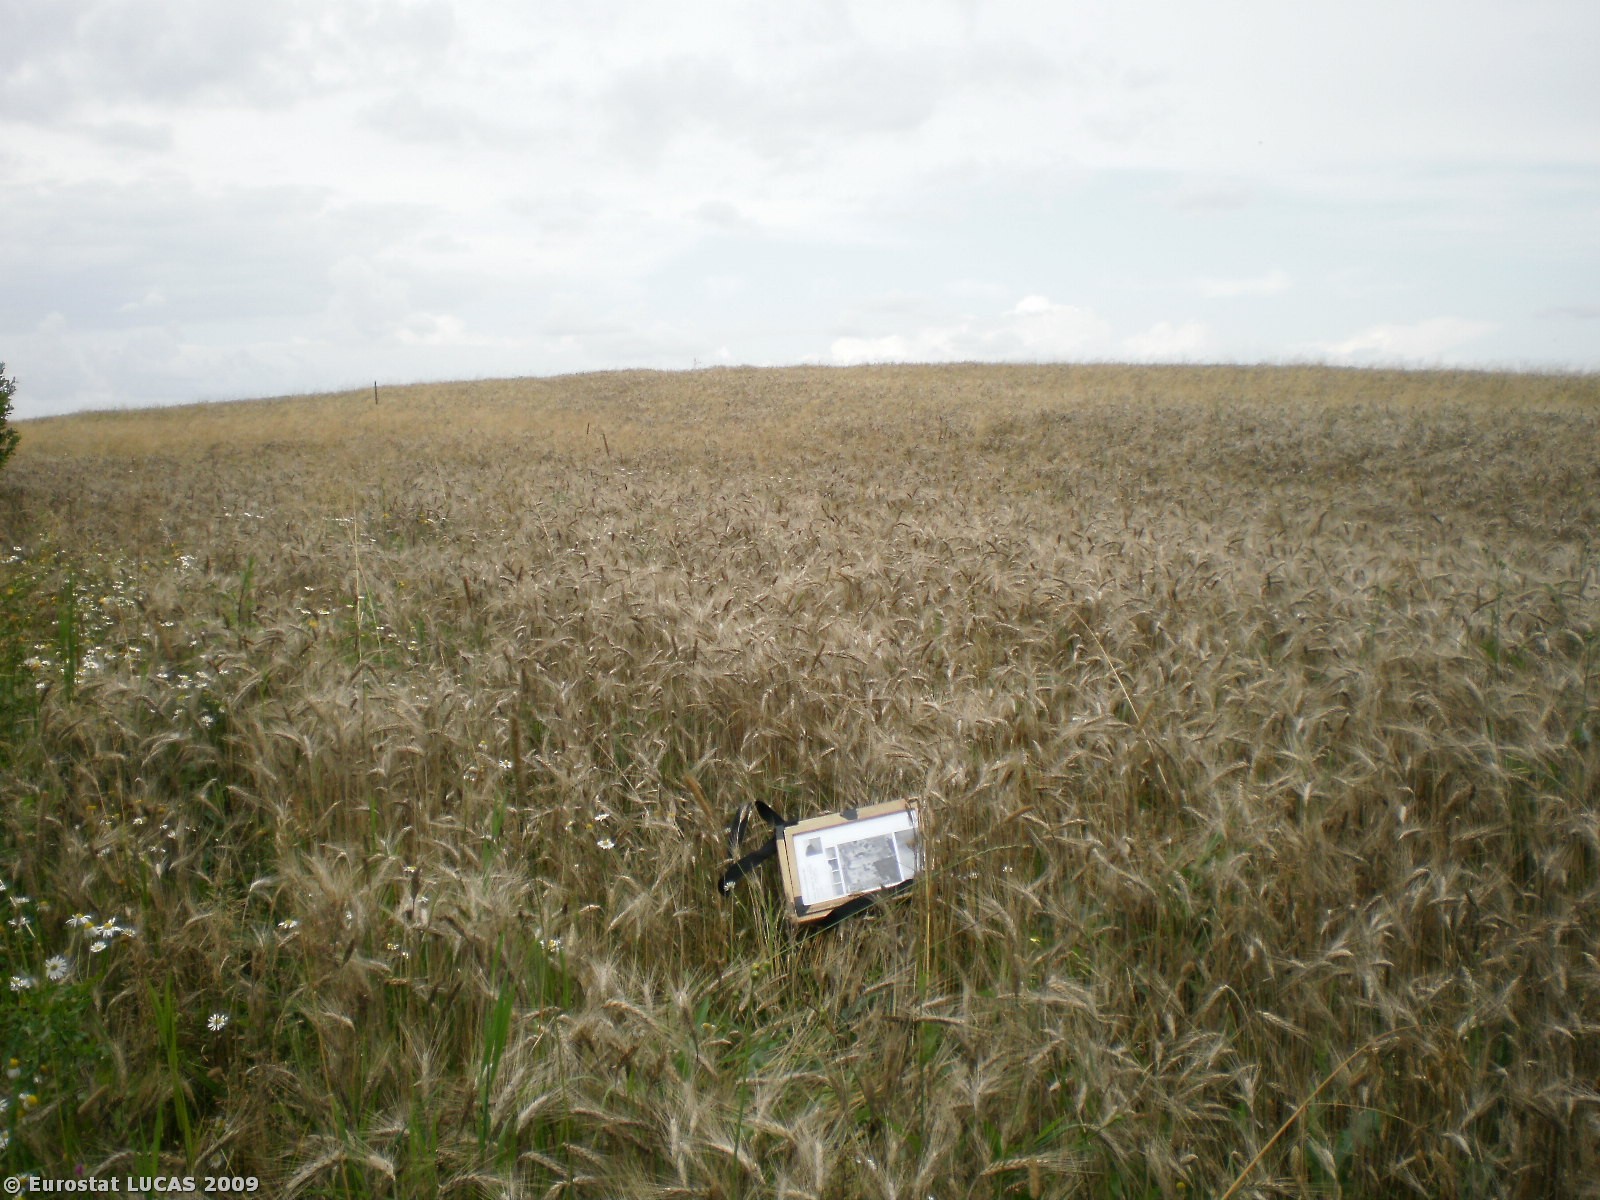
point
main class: Cropland
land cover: Triticale
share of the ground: > 75 %
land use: Agriculture (excluding fallow land and kitchen gardens)
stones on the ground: < 10 %
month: August
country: PL
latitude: 54.0881
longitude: 20.6944
